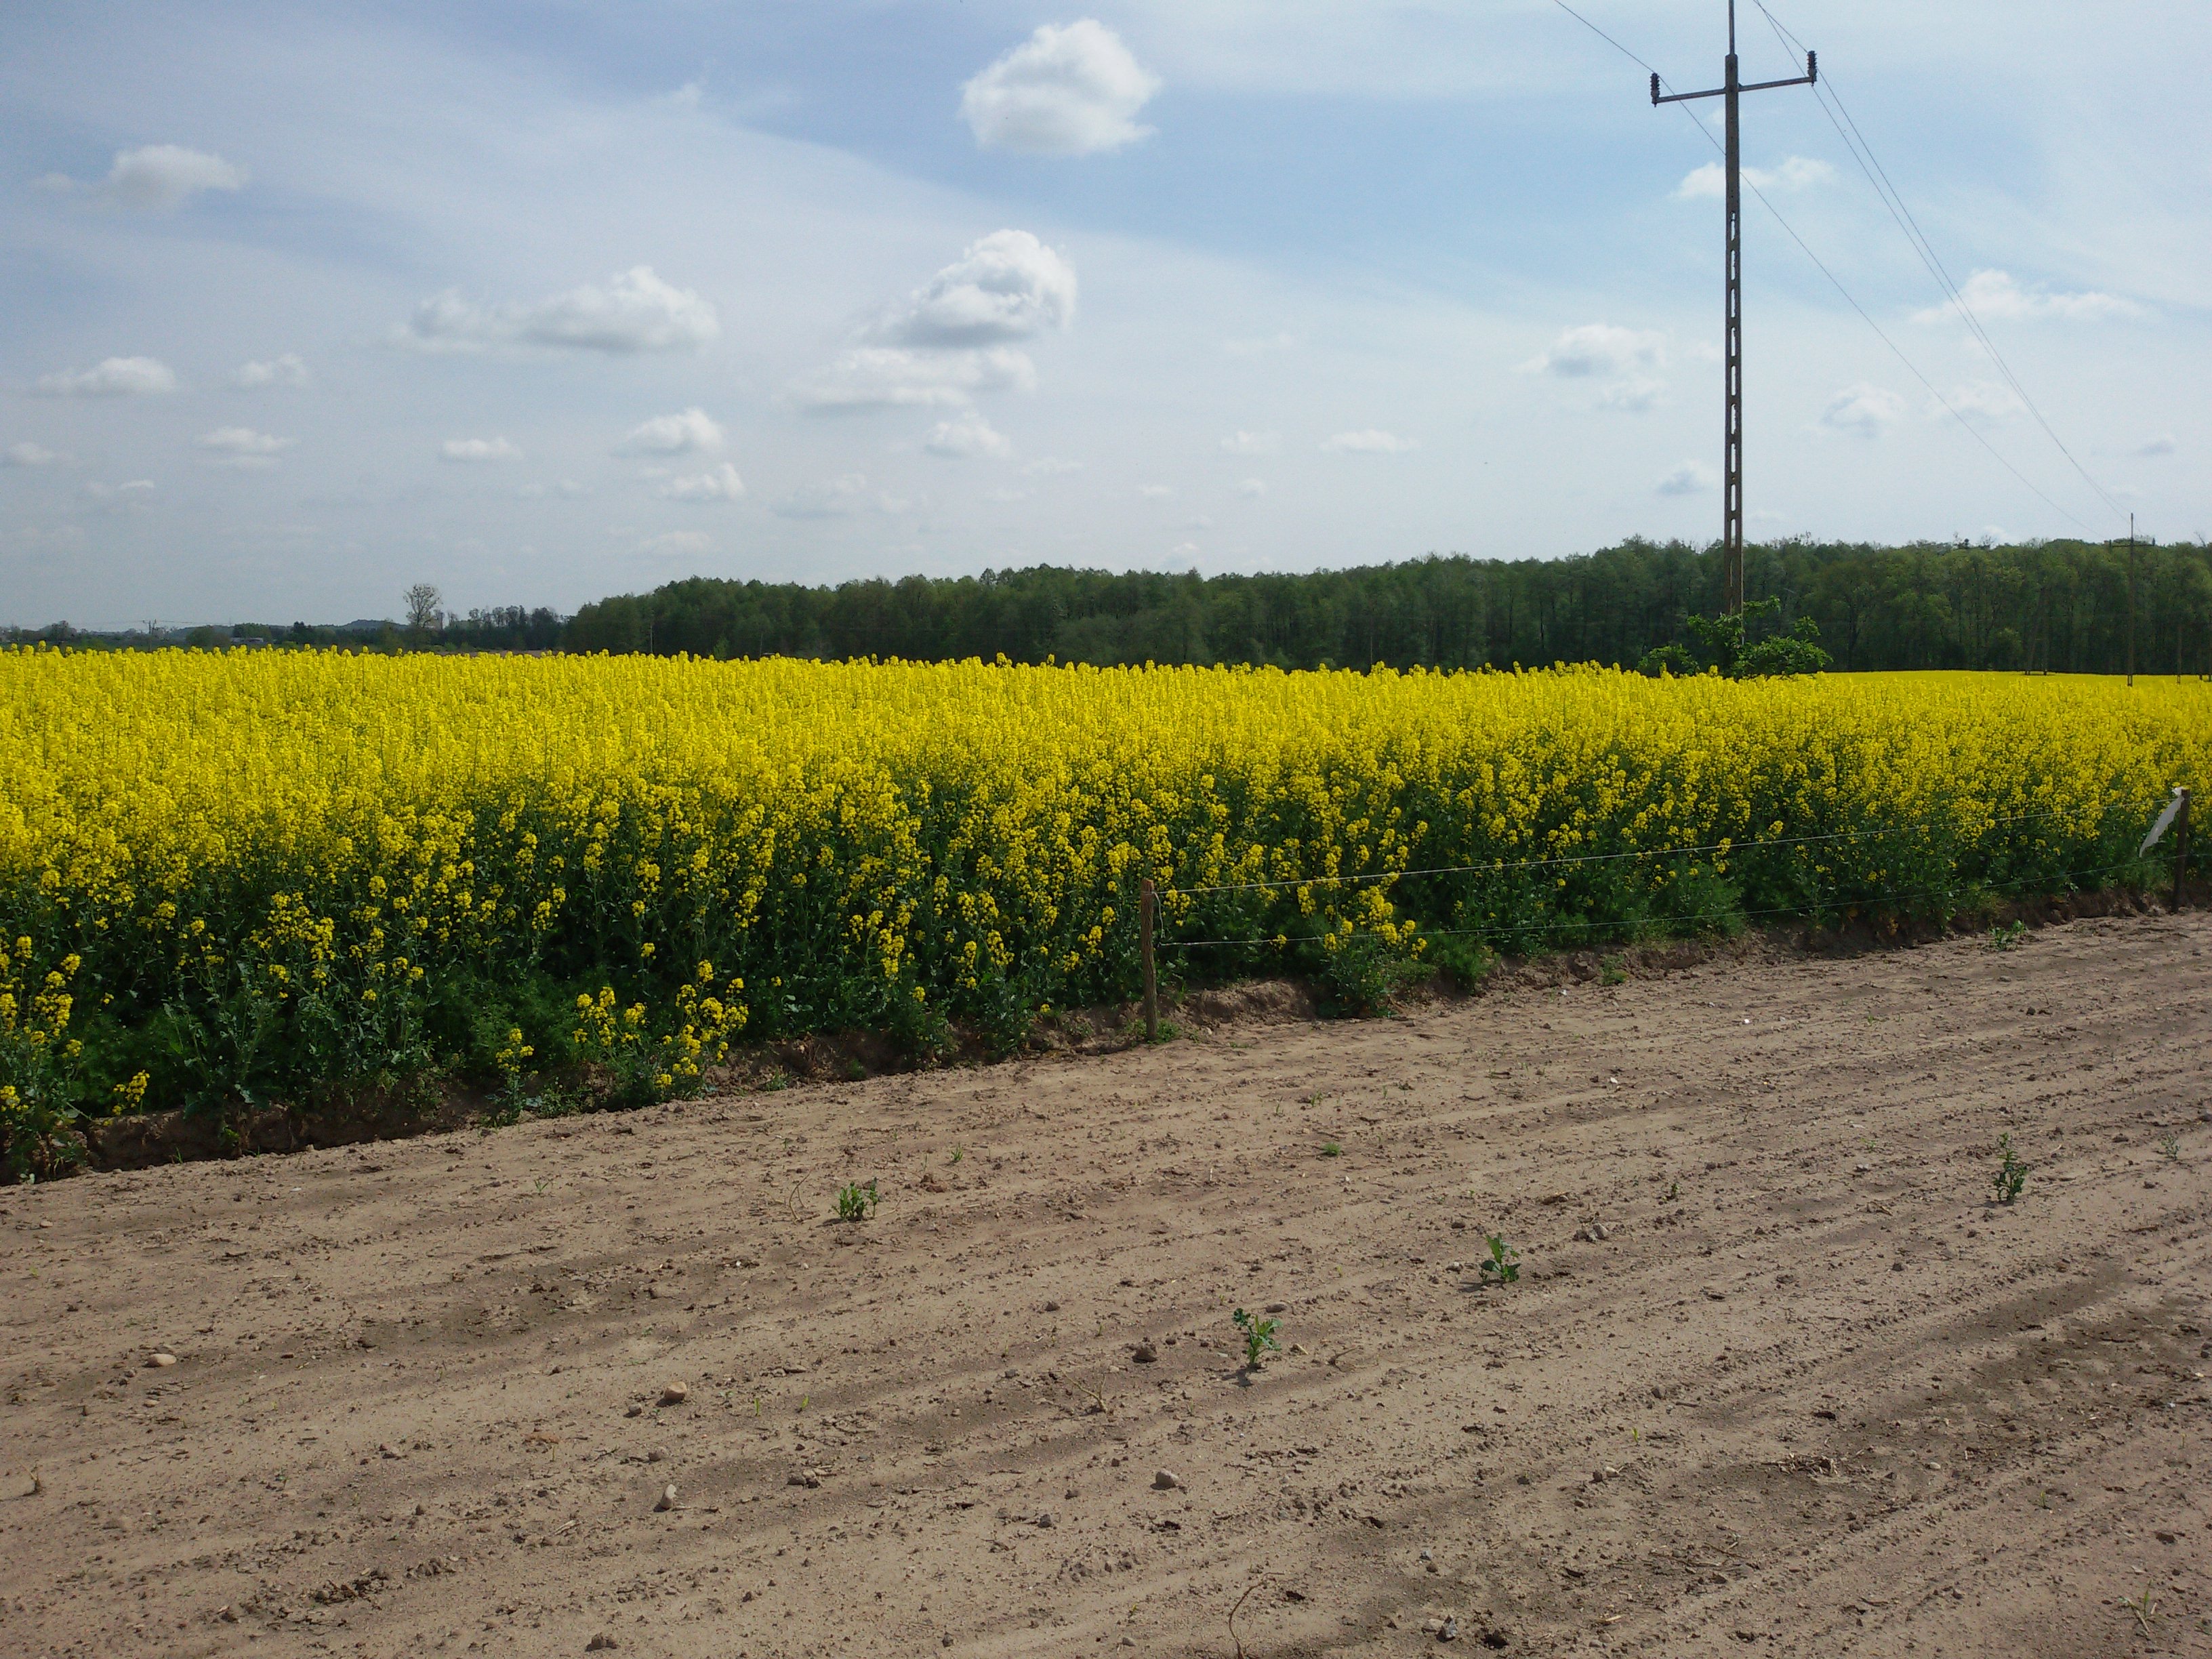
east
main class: Cropland
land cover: Common wheat
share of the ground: < 10 %
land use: Agriculture (excluding fallow land and kitchen gardens)
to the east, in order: Common wheat; Electric lines; Fences; Rape and turnip rape; Electric lines; Rape and turnip rape
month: May
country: PL
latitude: 52.4841
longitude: 16.2353
